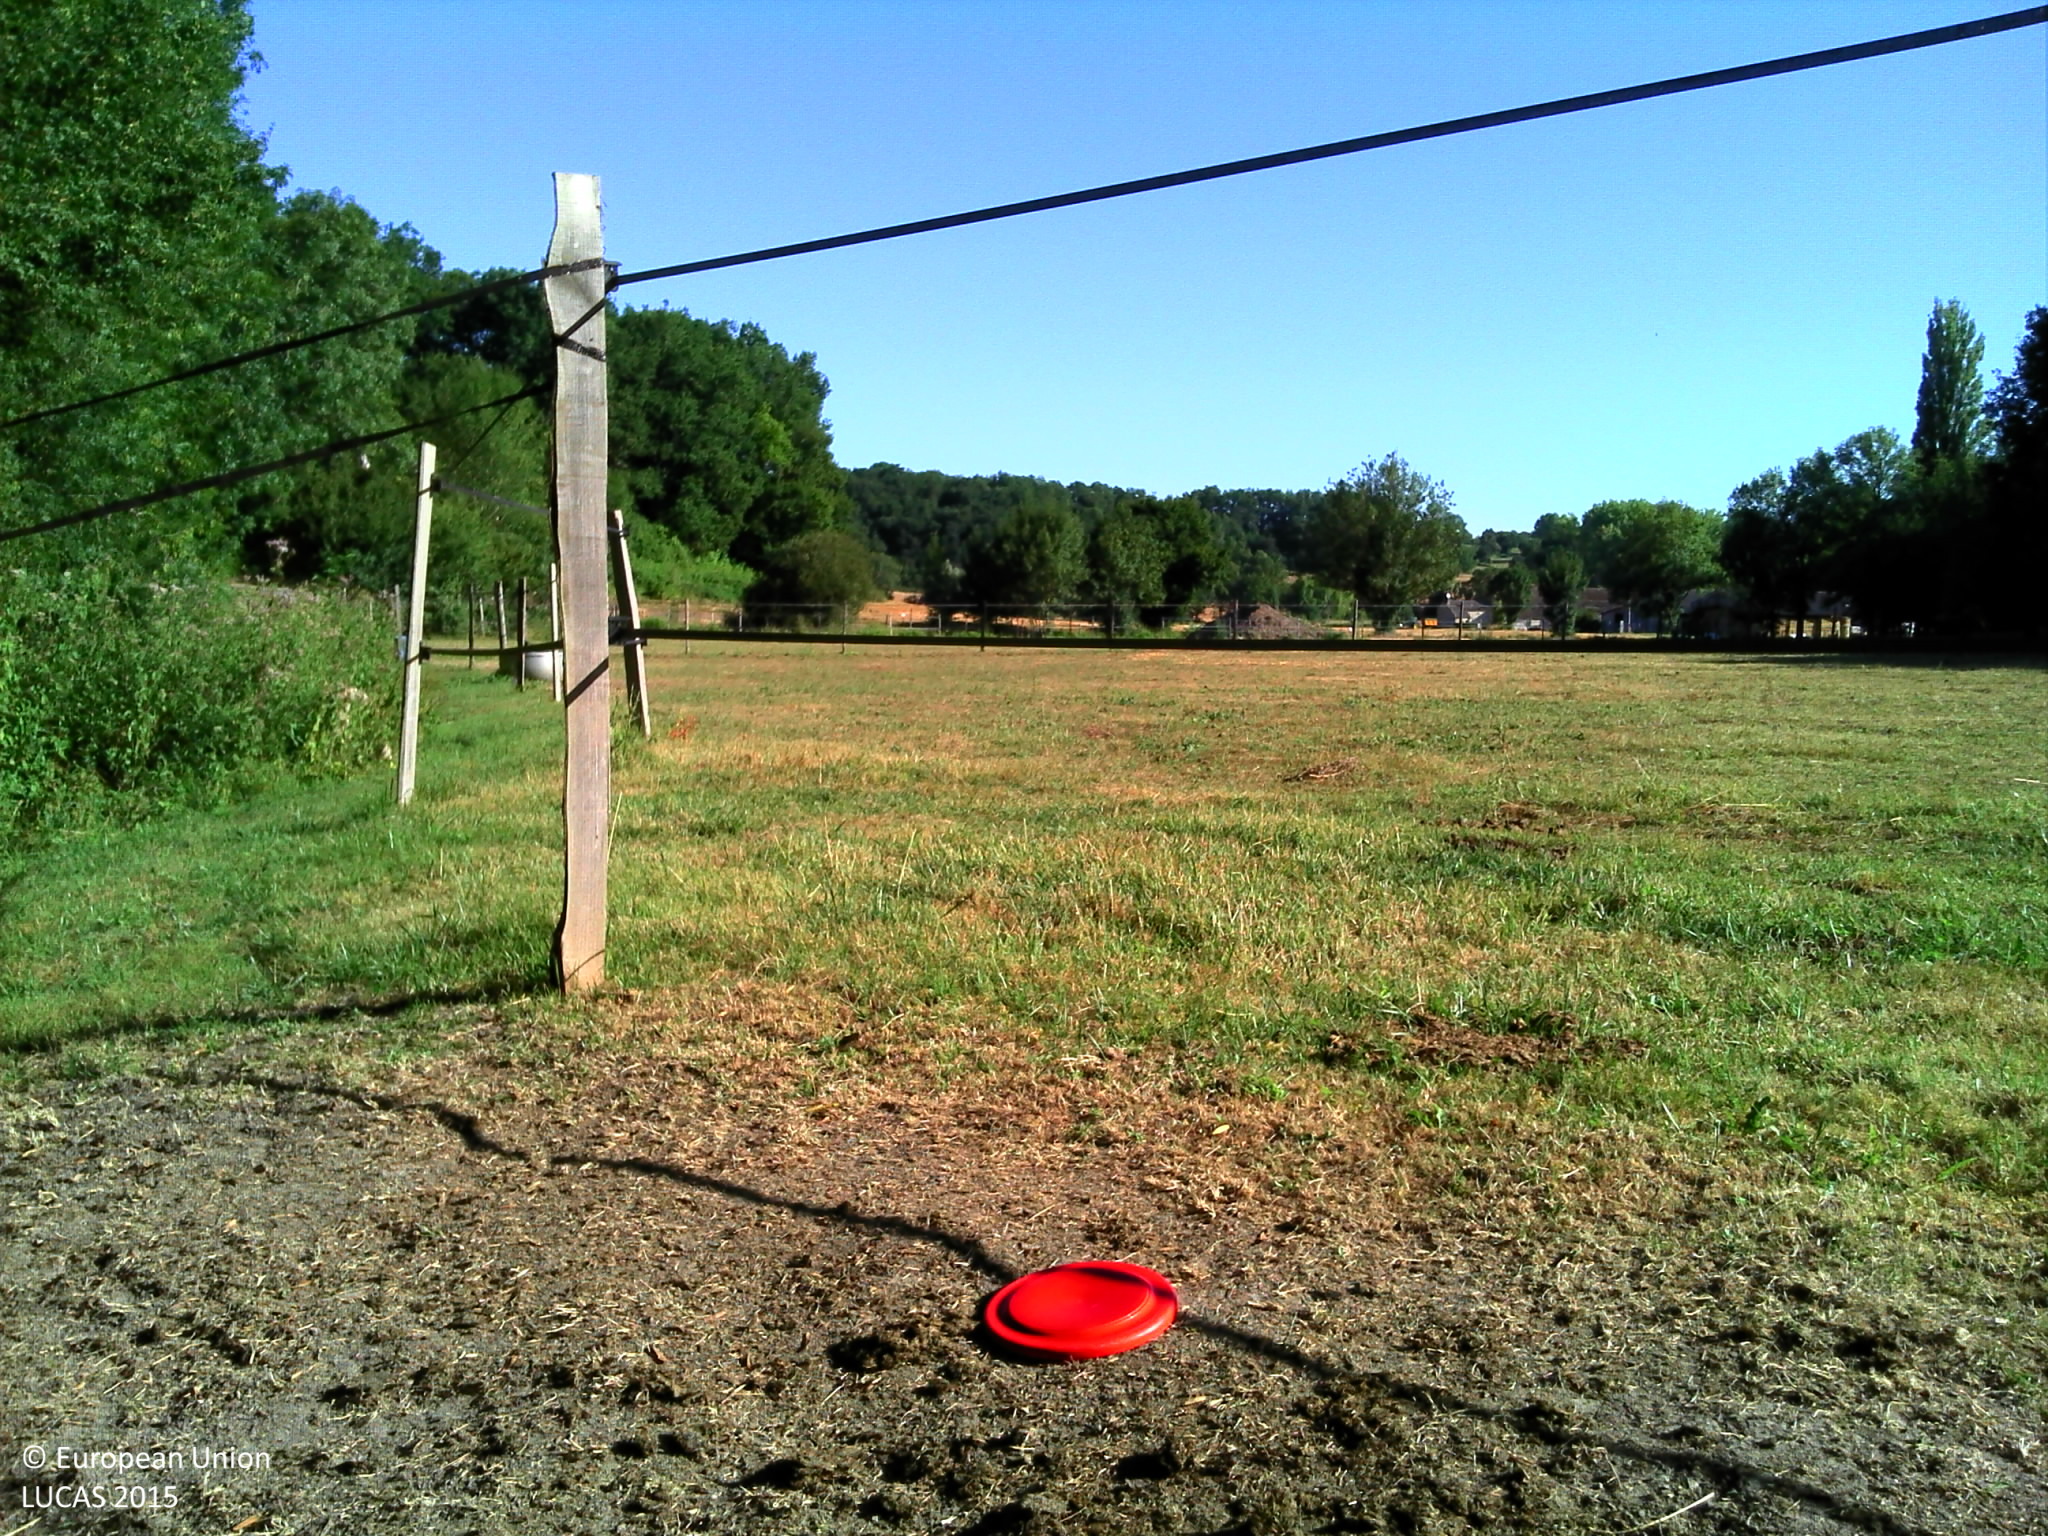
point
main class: Grassland
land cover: Grassland without tree/shrub cover
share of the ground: > 75 %
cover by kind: herbaceous plants 90 %, lichens and mosses 10 %
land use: Agriculture (excluding fallow land and kitchen gardens)
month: July
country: FR
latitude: 44.7559
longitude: 0.5803
